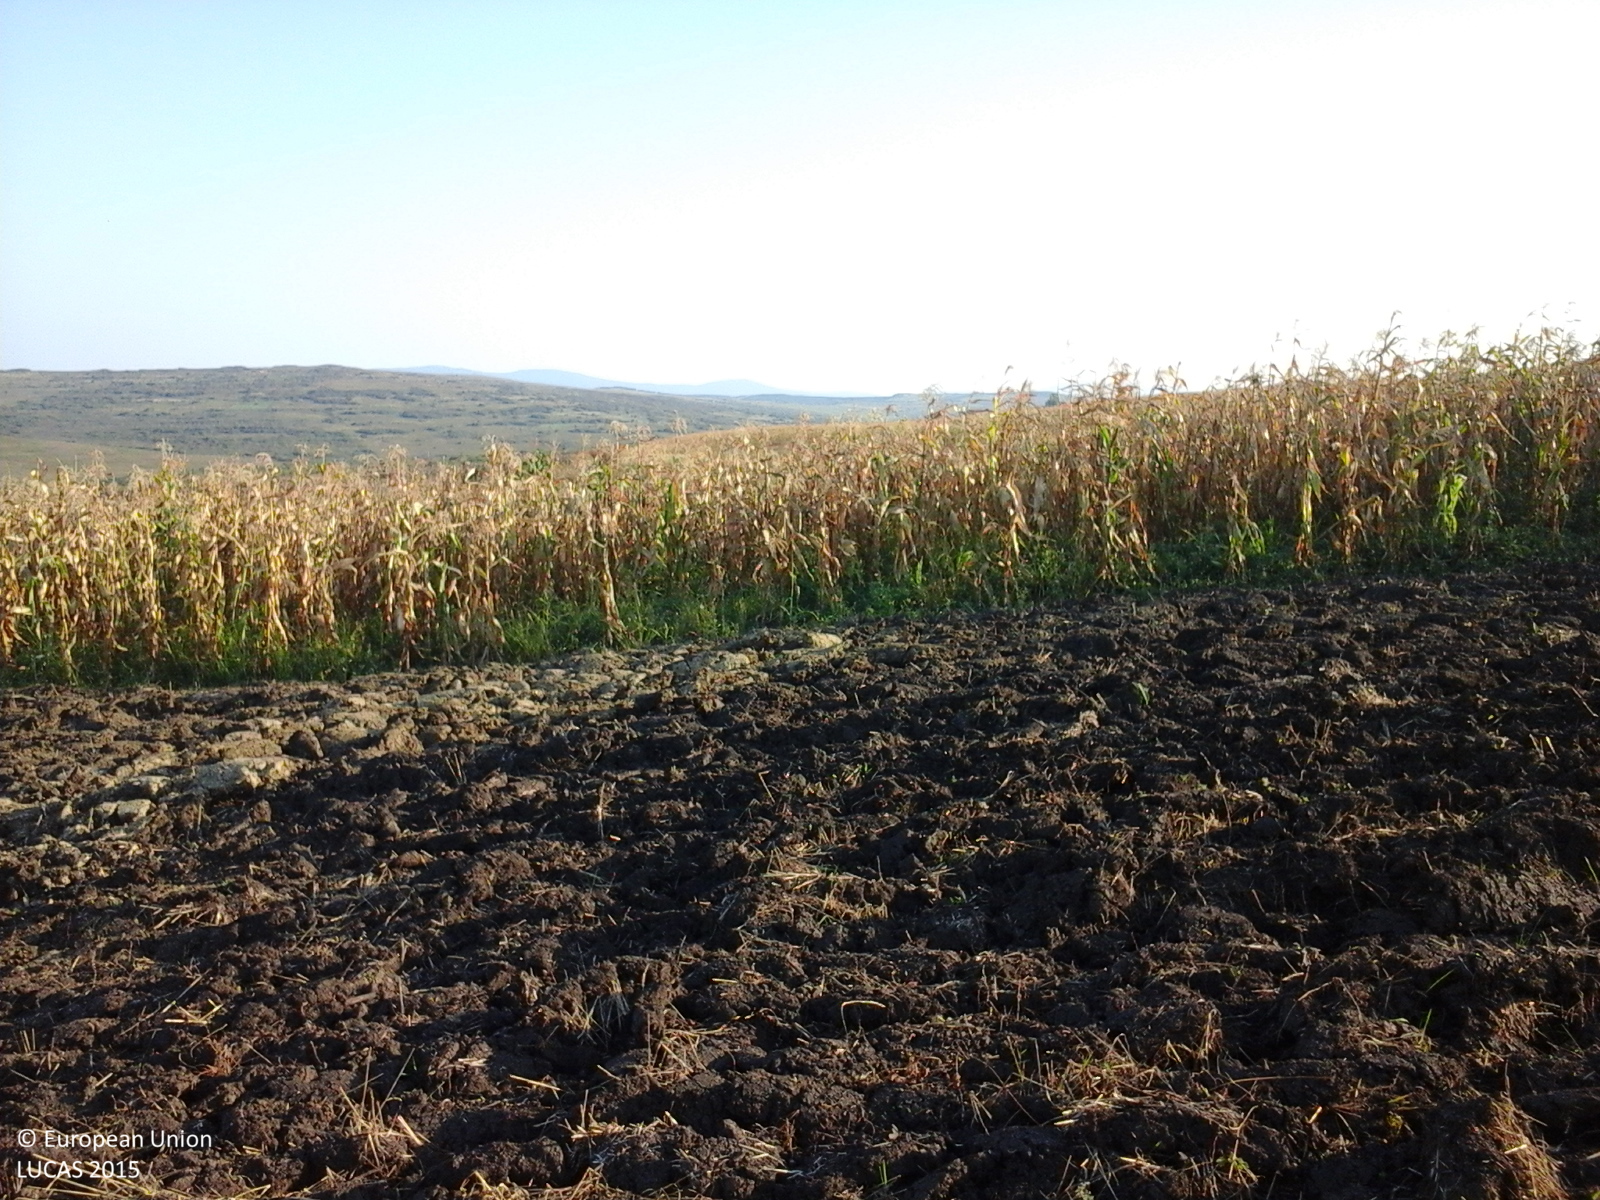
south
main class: Cropland
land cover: Oats
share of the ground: < 10 %
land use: Agriculture (excluding fallow land and kitchen gardens)
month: September
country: RO
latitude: 47.2994
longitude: 23.0383
